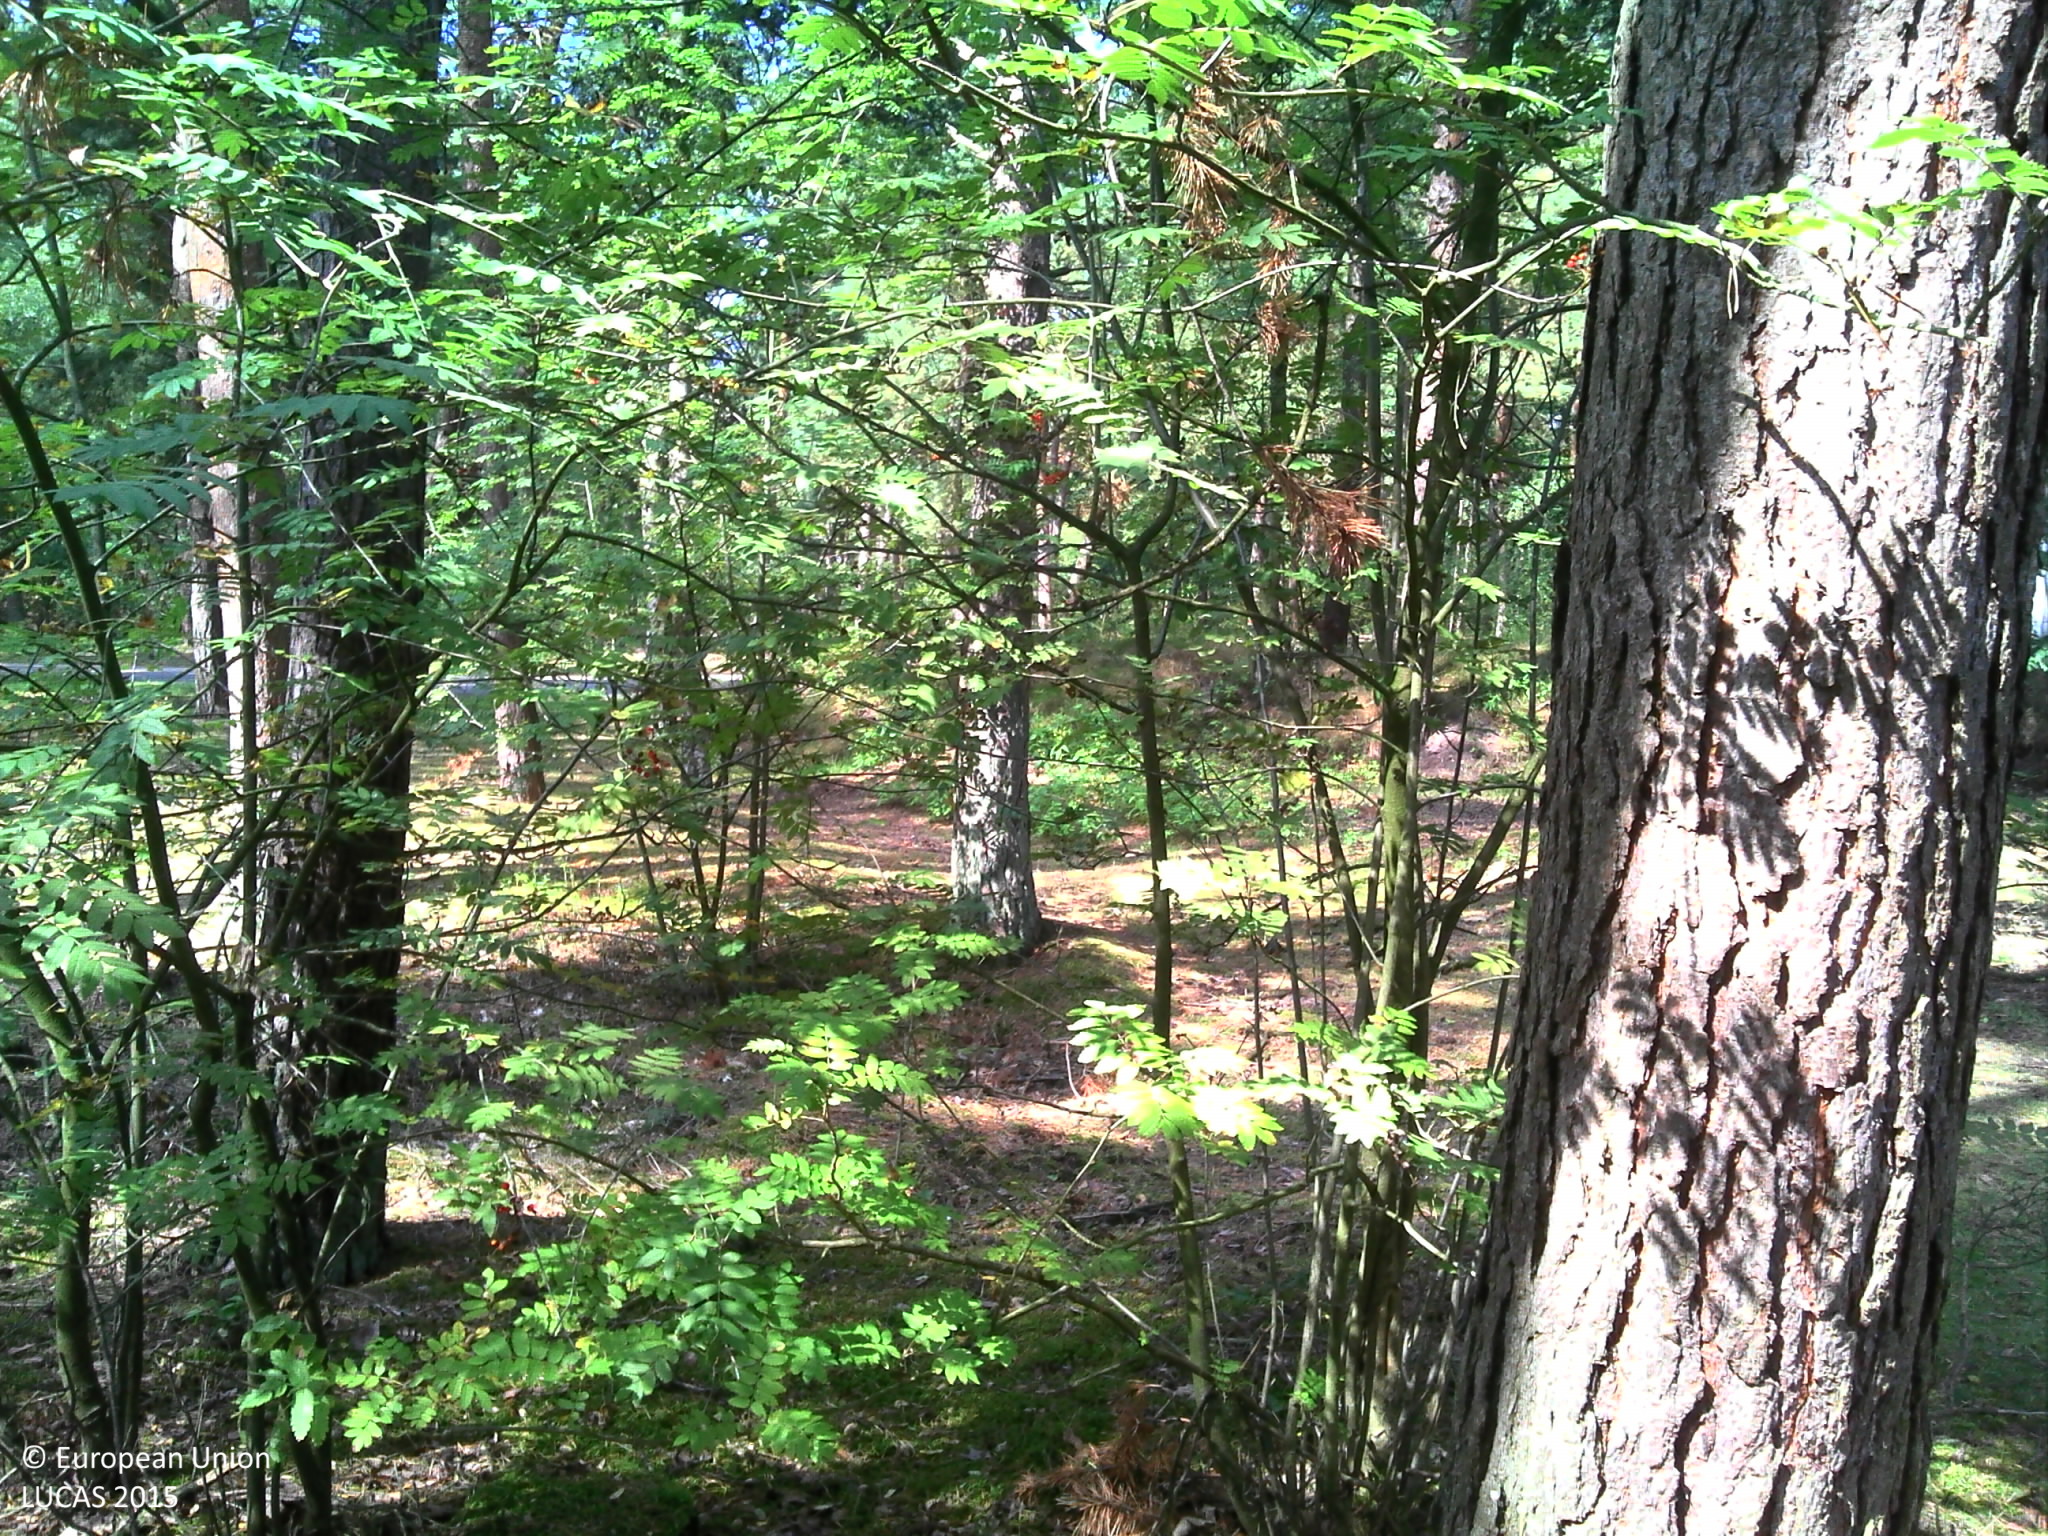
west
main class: Woodland
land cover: Pine dominated coniferous woodland
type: exotic forest
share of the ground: > 75 %
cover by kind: coniferous forest trees 90 %, broadleaved forest trees 5 %, lichens and mosses 5 %
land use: Amenities, museums, leisure
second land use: Residential
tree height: > 5 m
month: August
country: BE
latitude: 51.2168
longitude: 5.1727
